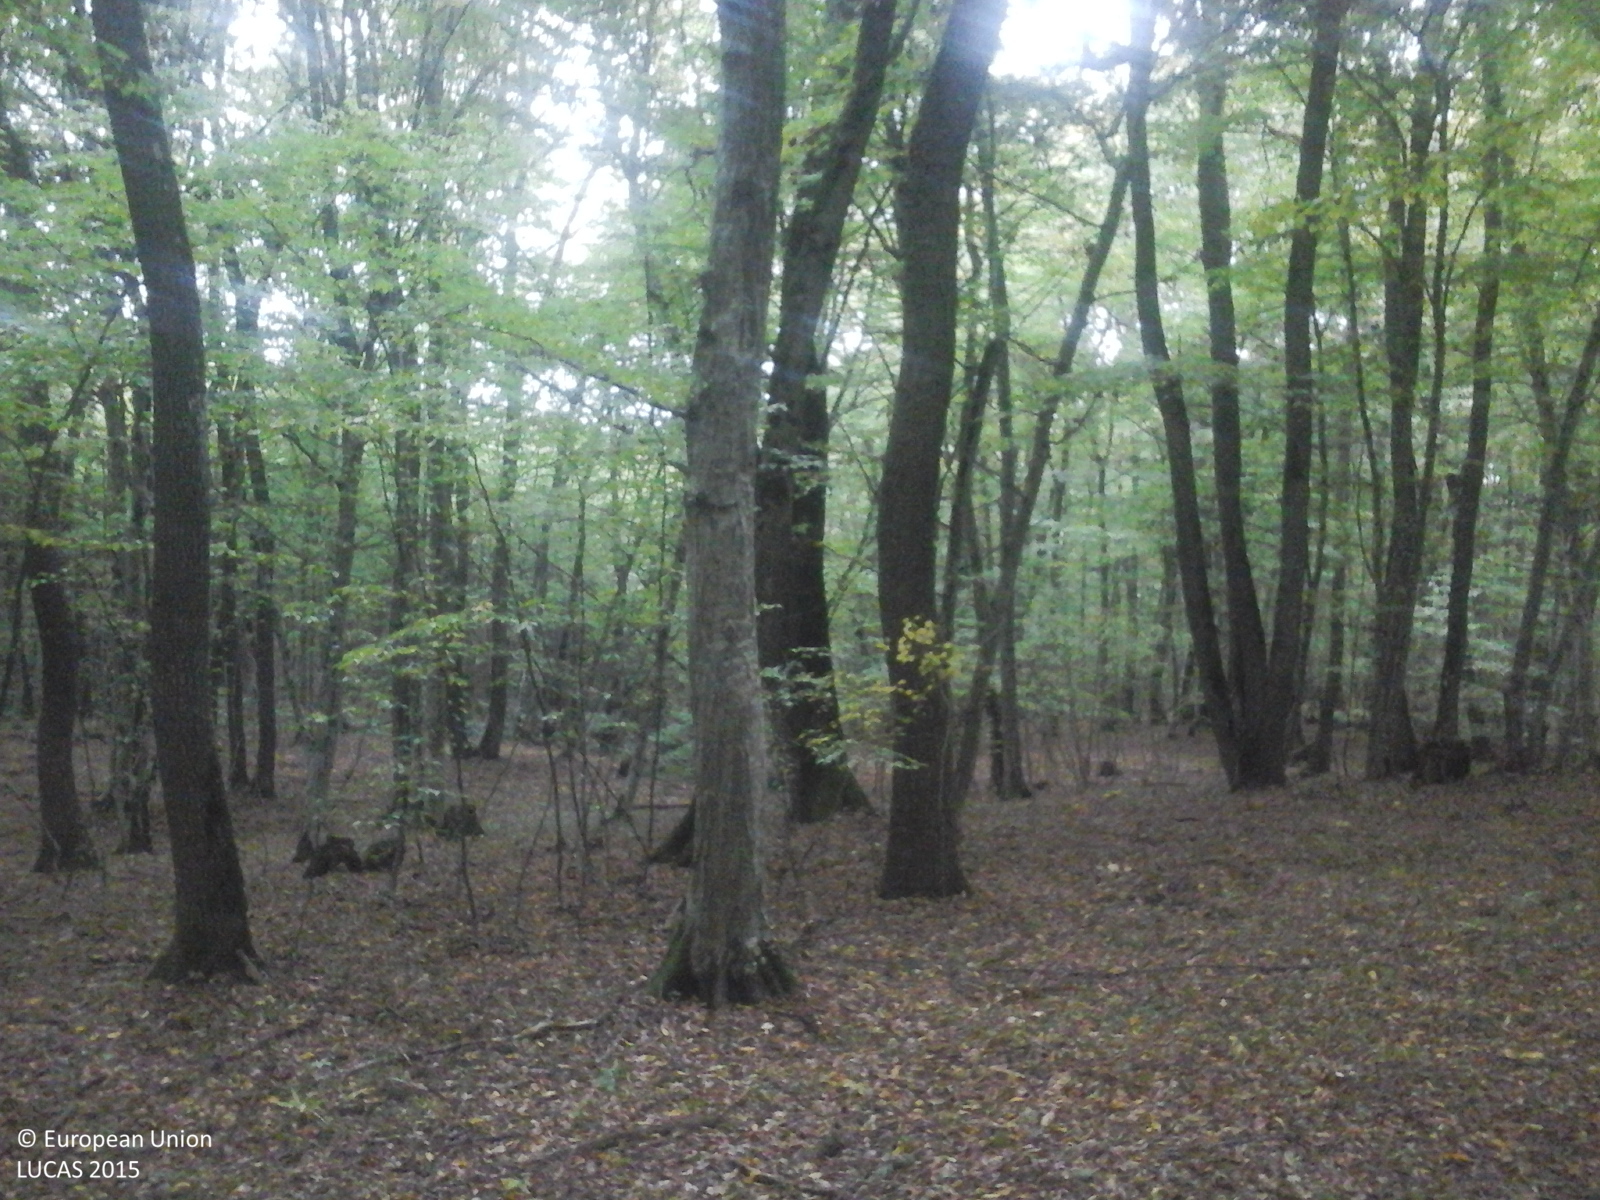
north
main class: Woodland
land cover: Broadleaved woodland
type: beech forest
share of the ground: > 75 %
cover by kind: broadleaved forest trees 100 %
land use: Forestry
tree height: > 5 m
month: October
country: RO
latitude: 45.9880
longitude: 25.0835
